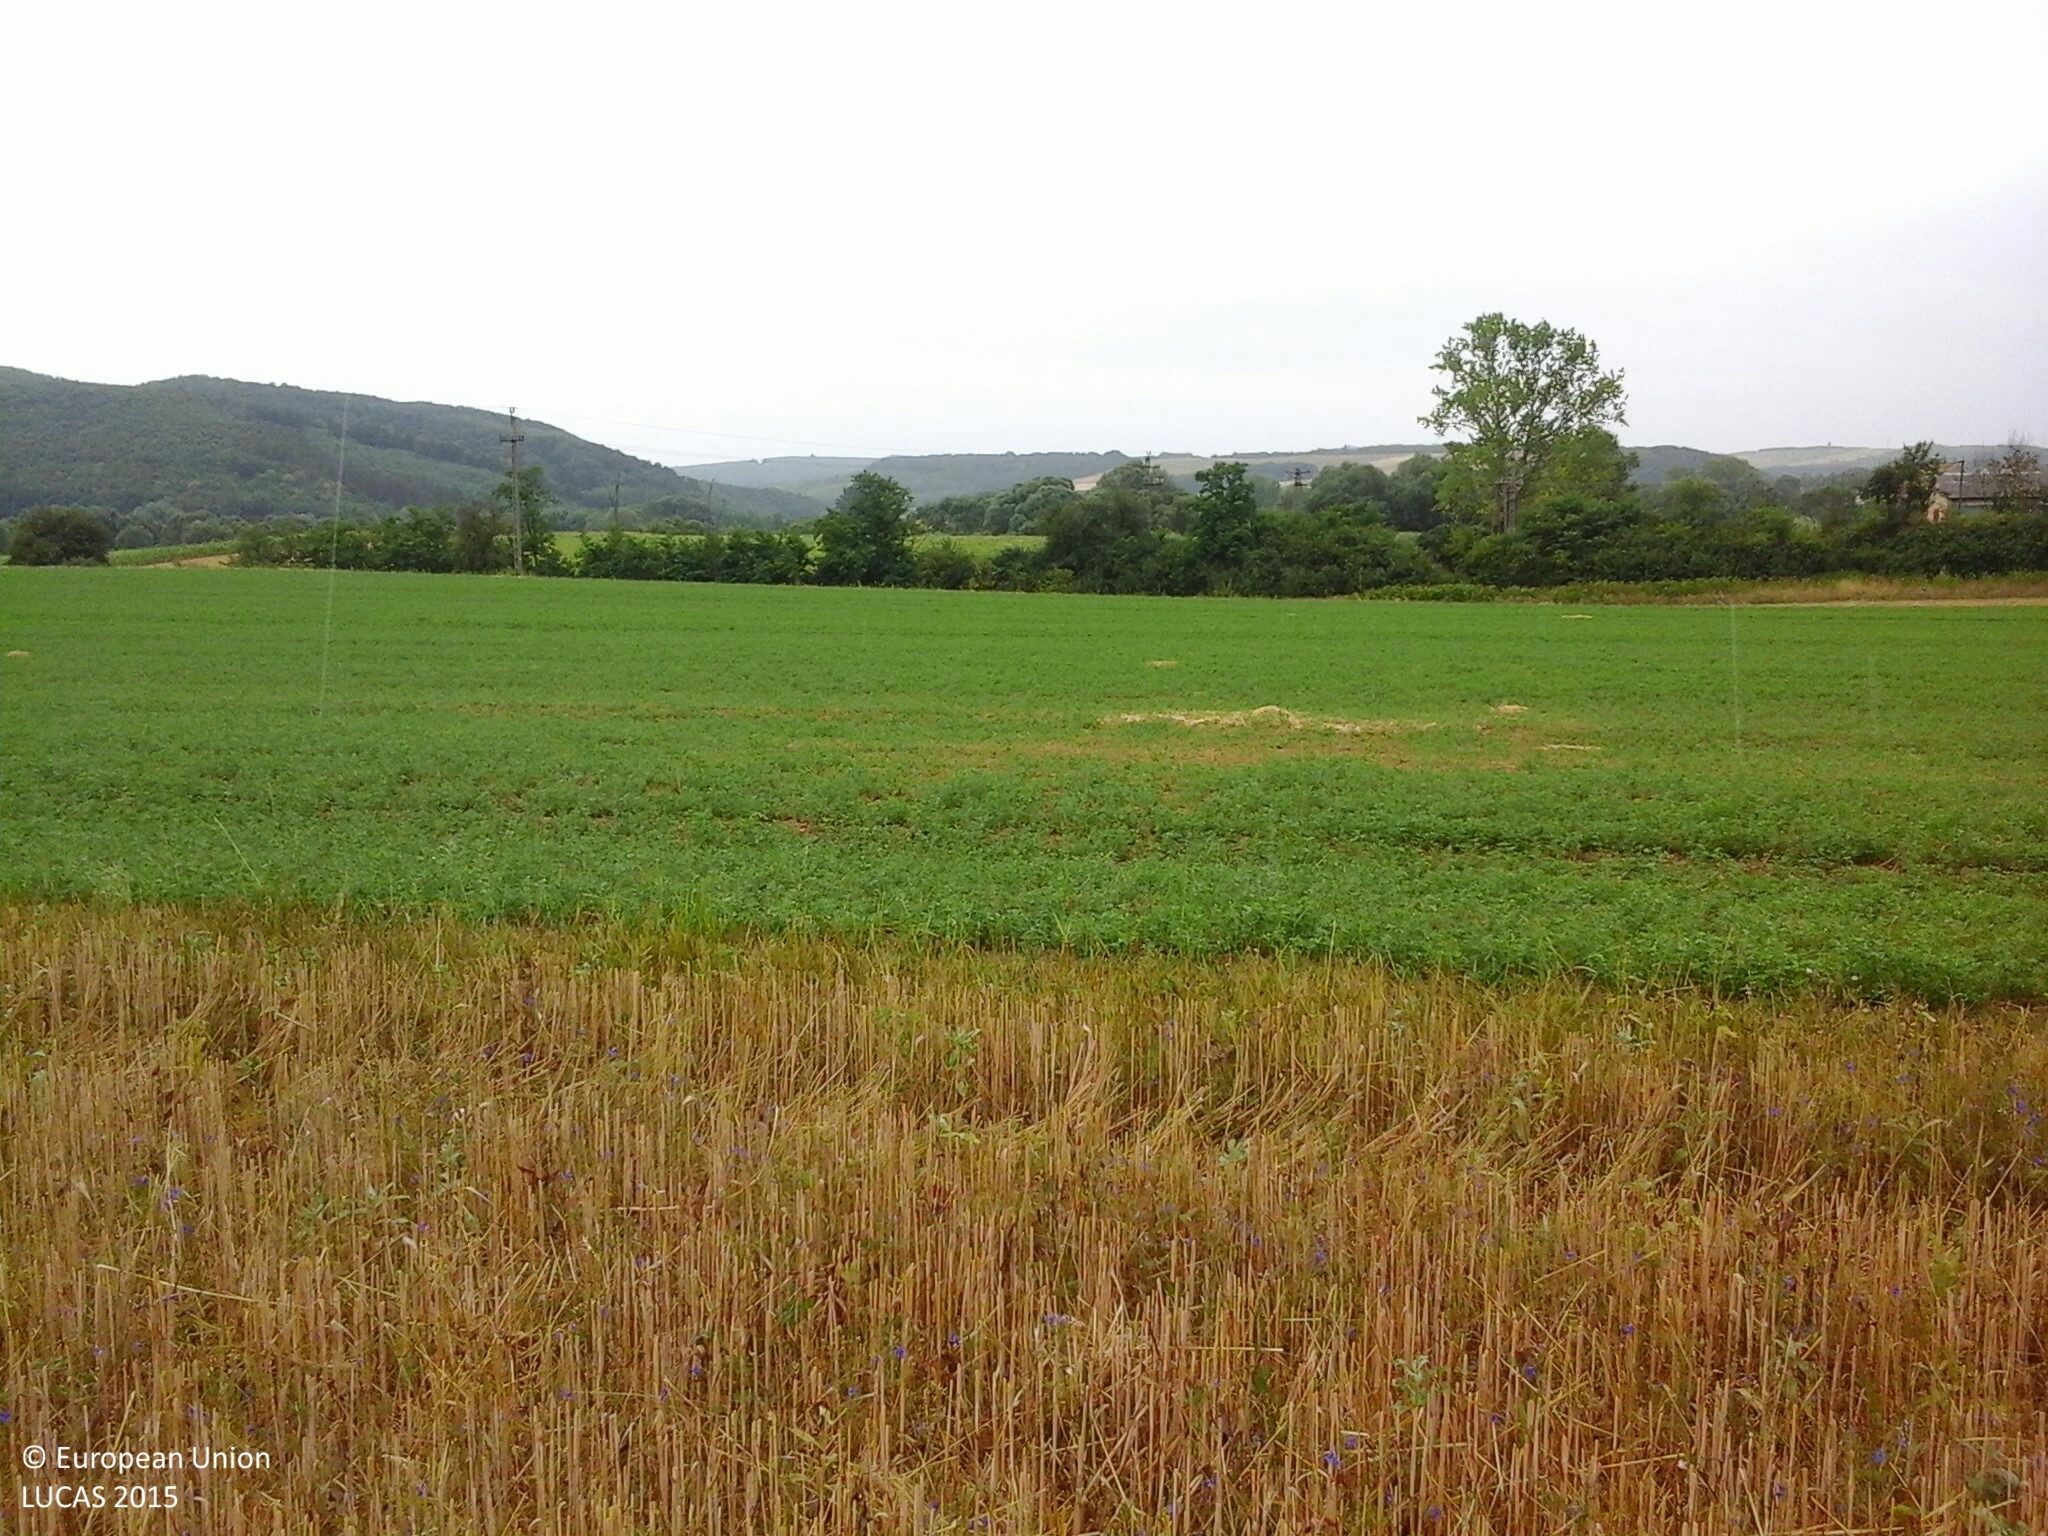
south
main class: Cropland
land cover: Barley
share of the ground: 25 - 50 %
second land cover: Spontaneously vegetated surfaces
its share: < 10 %
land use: Agriculture (excluding fallow land and kitchen gardens)
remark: Harvested field
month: July
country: HU
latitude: 47.9696
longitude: 19.3581
